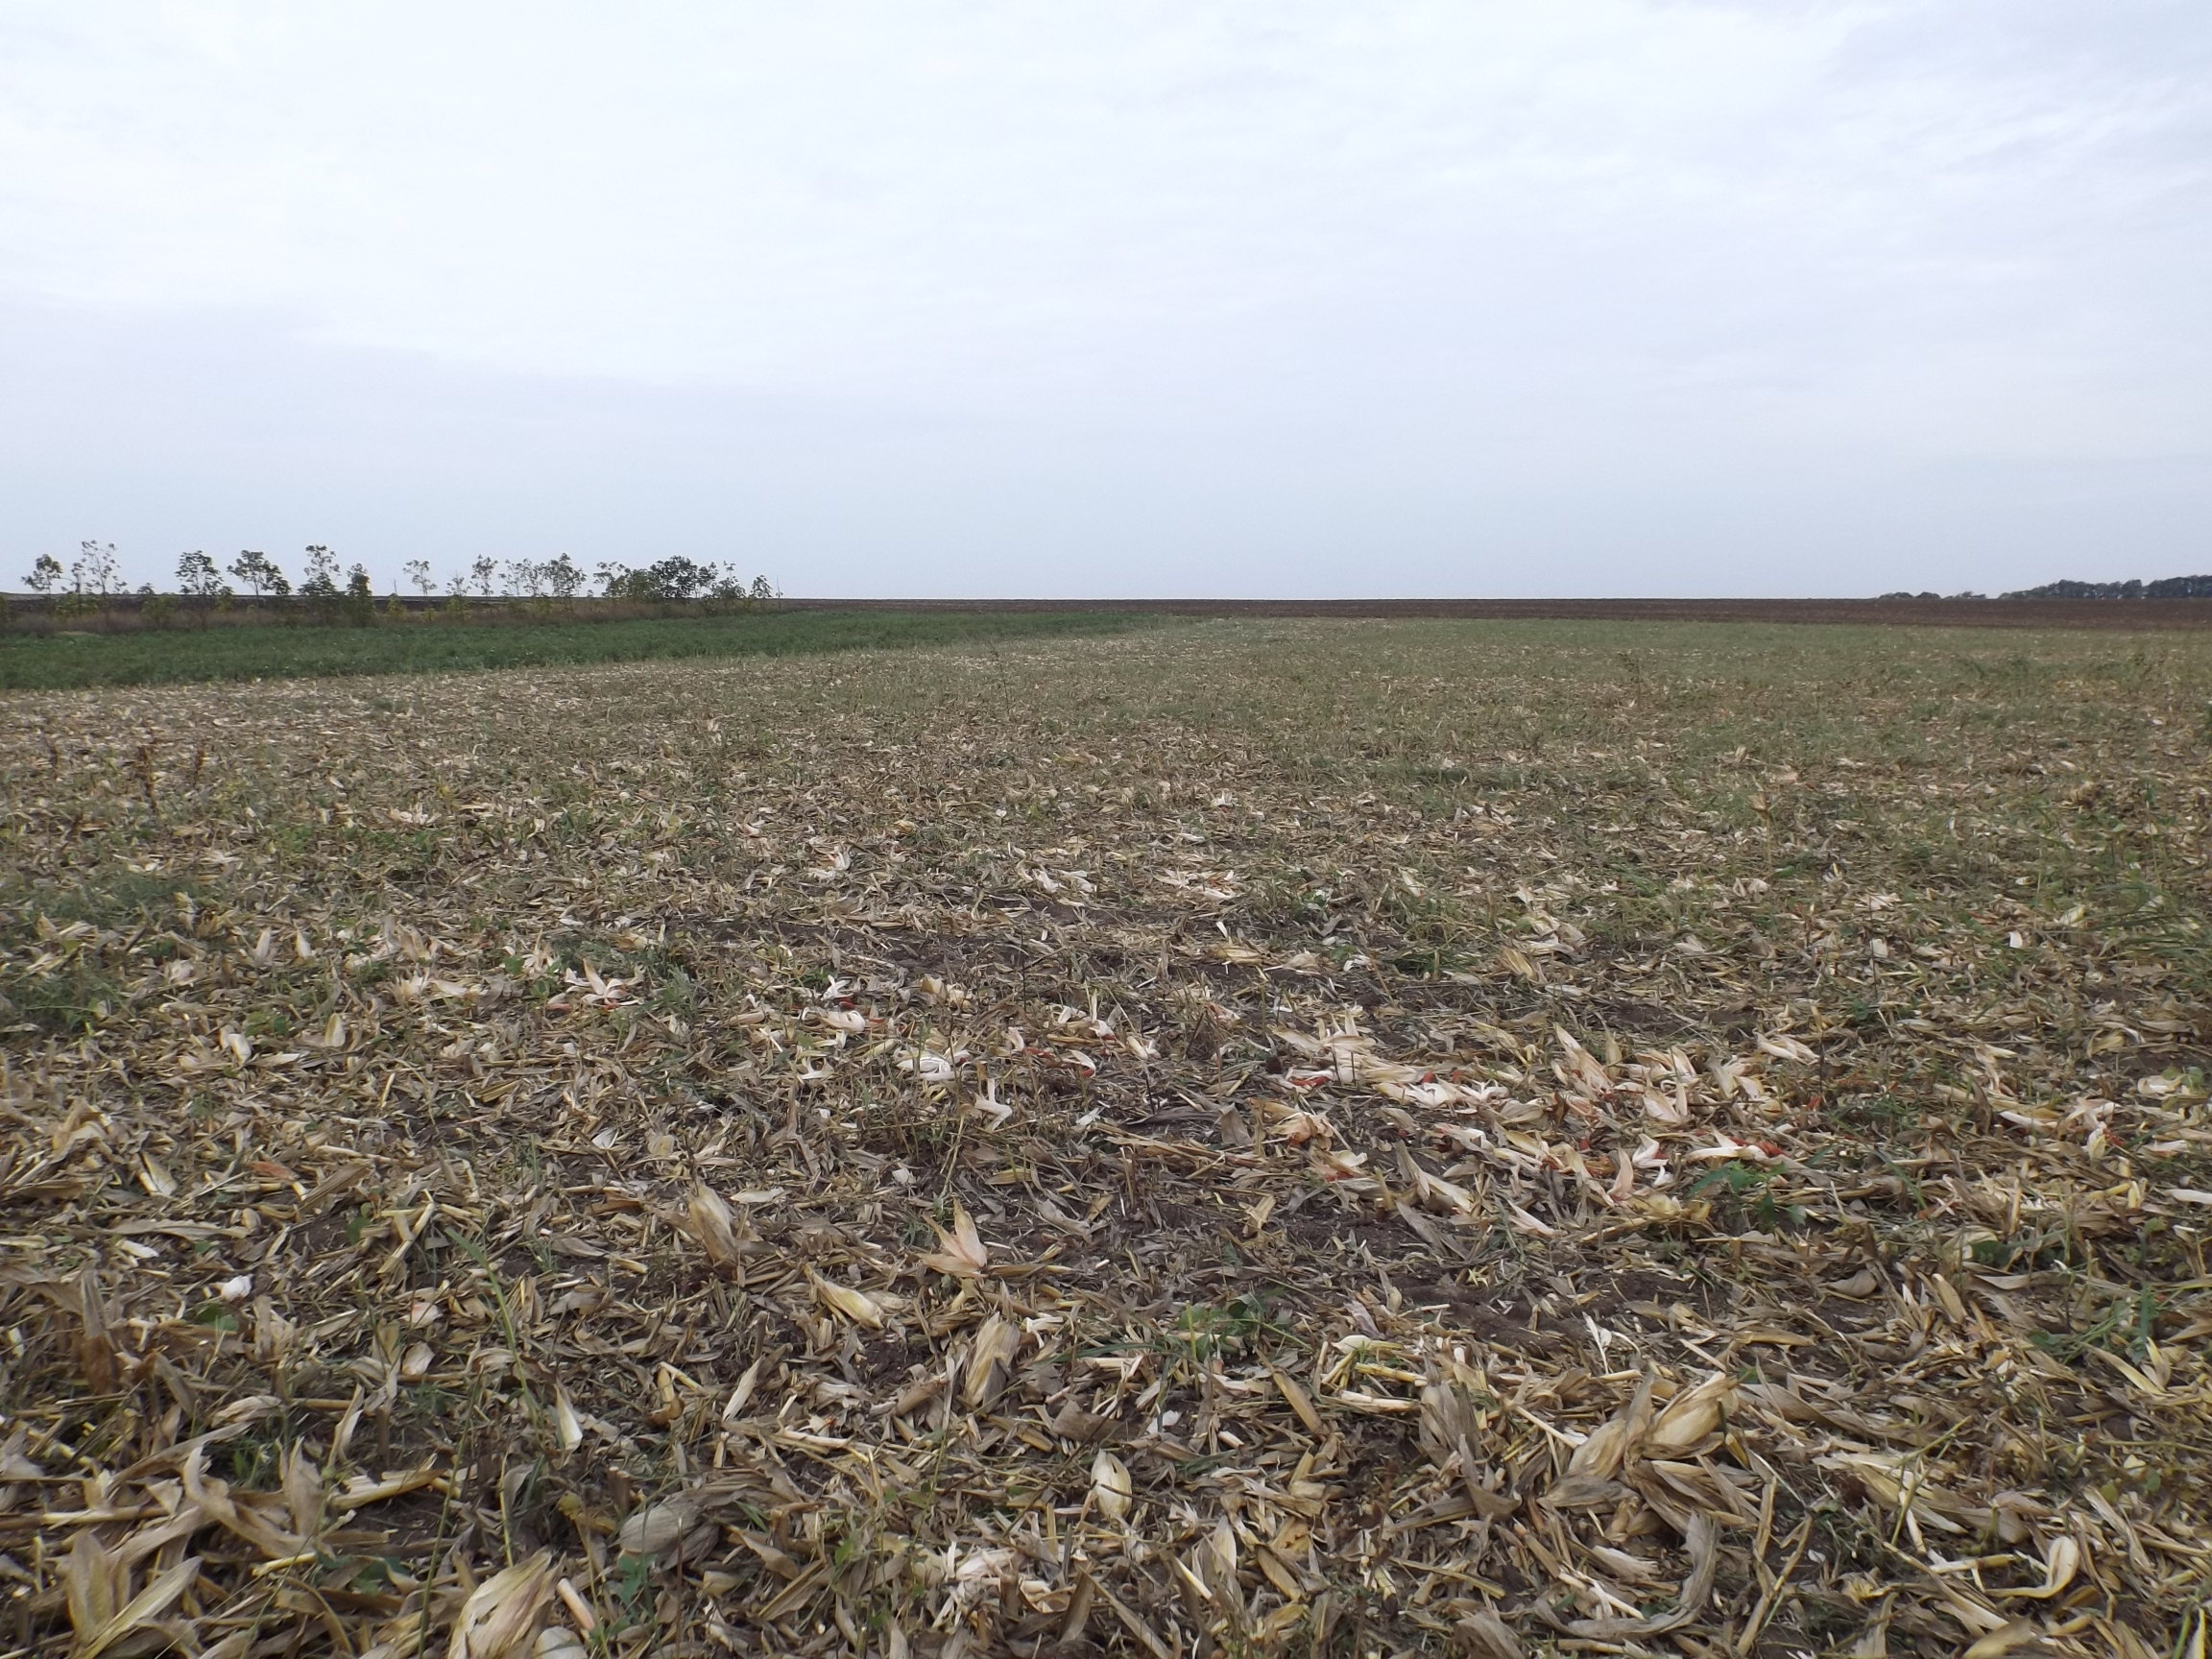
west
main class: Cropland
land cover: Maize
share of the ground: < 10 %
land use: Agriculture (excluding fallow land and kitchen gardens)
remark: Harvested field
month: October
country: BG
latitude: 43.9357
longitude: 26.8488
